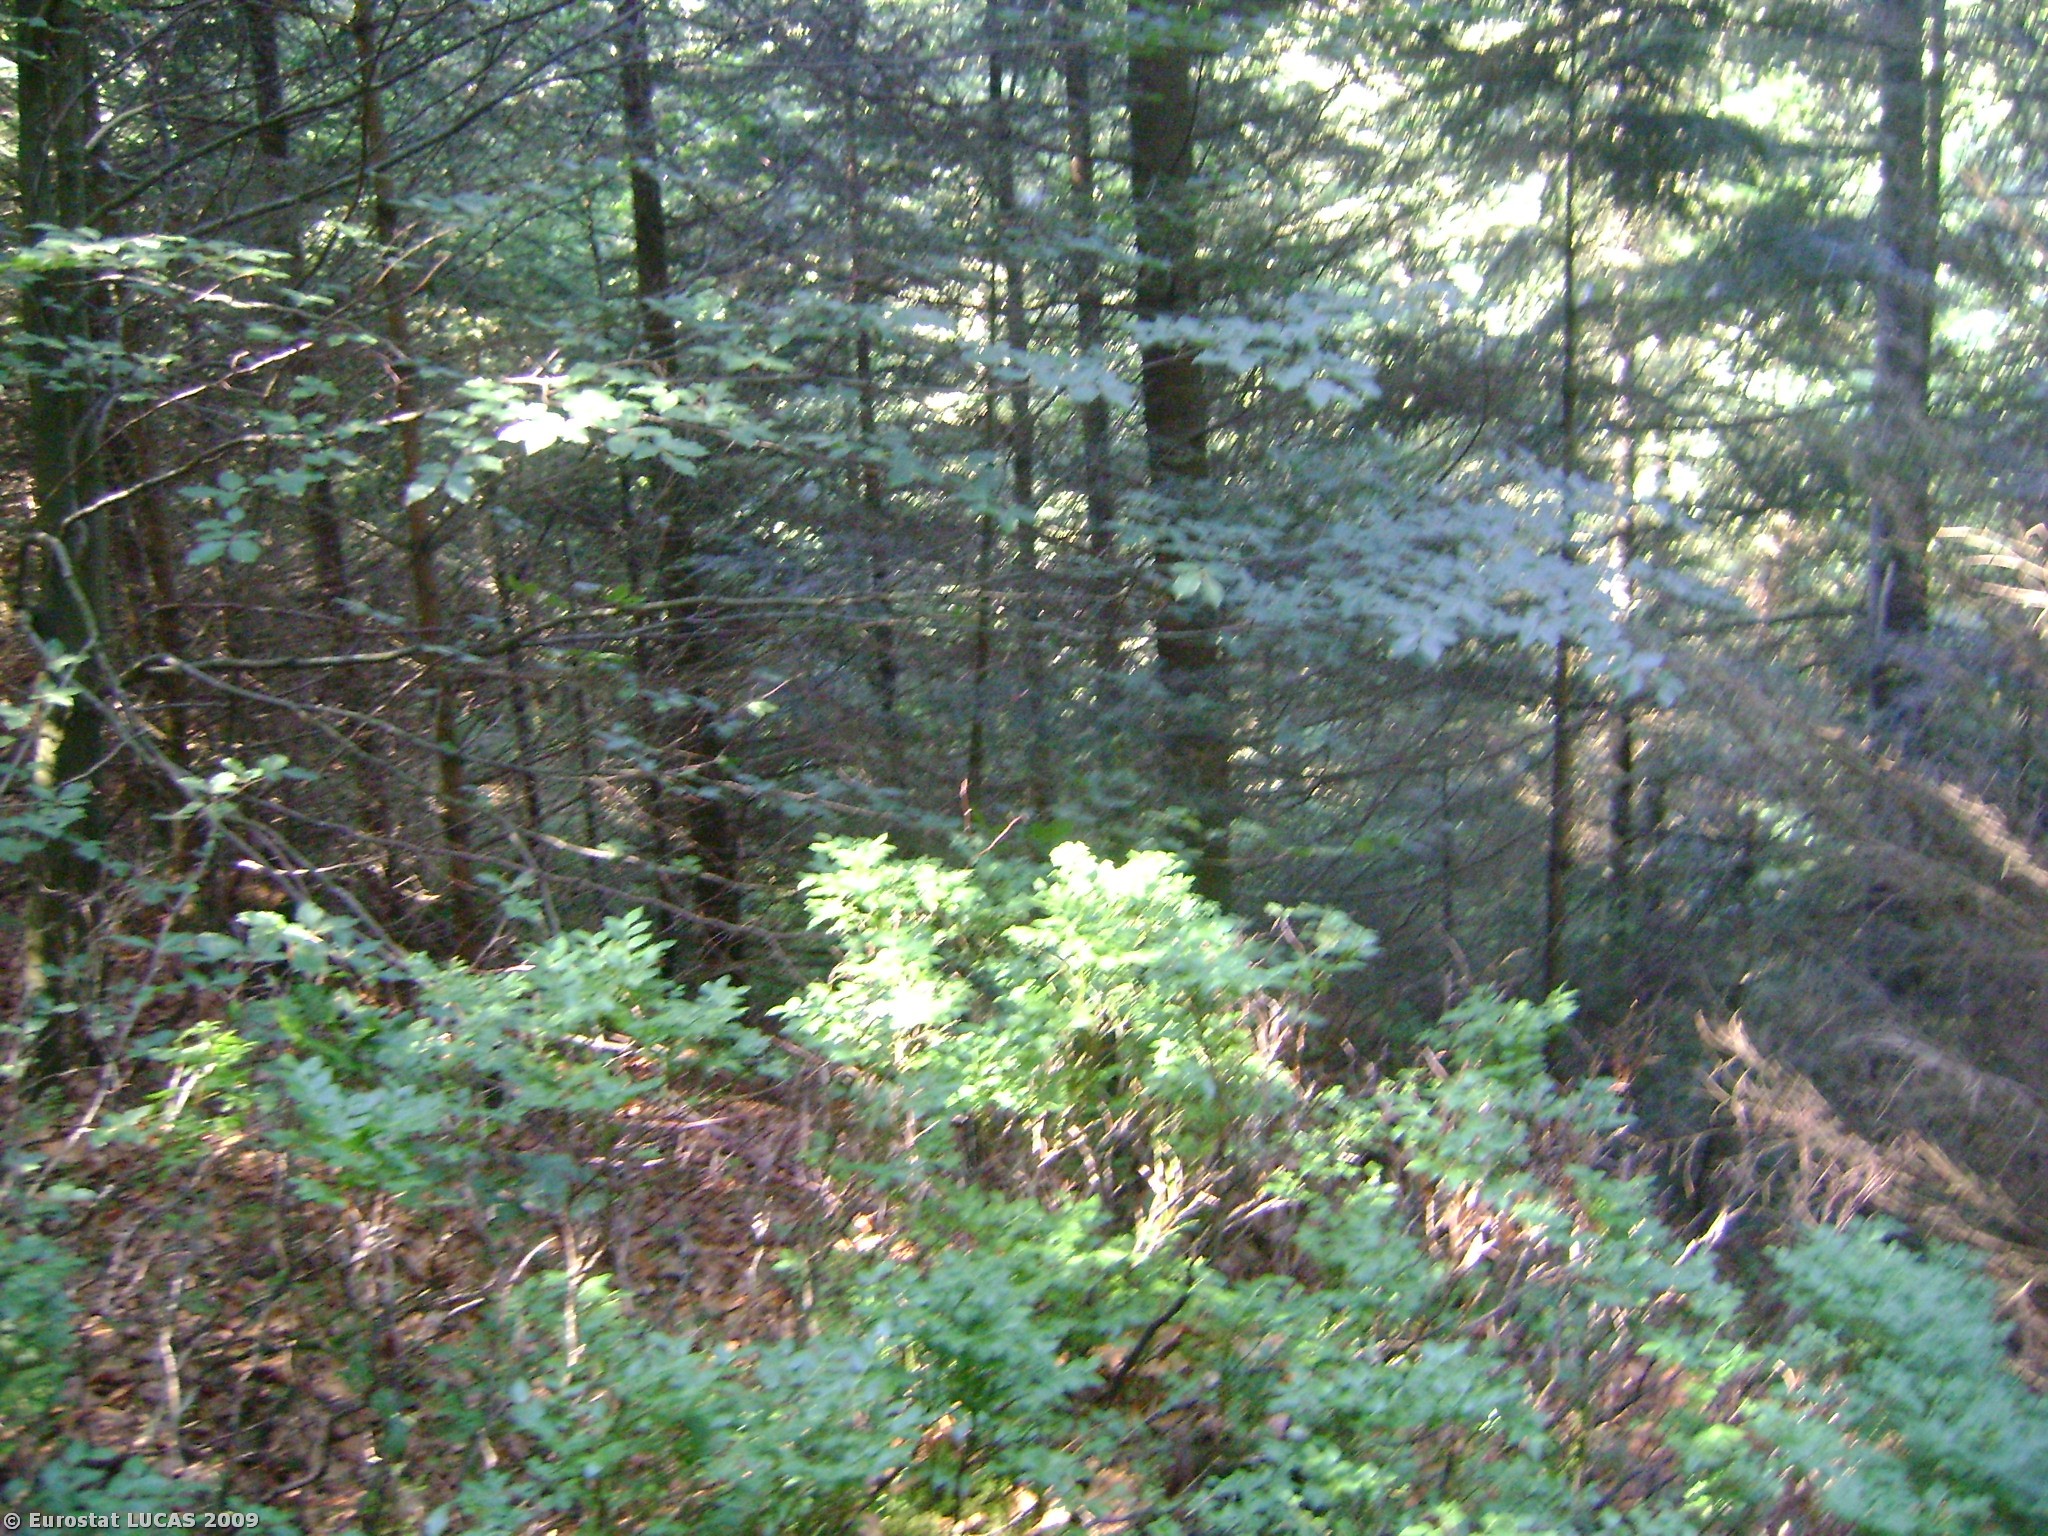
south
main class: Woodland
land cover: Coniferous woodland
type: hemiboreal forest and nemoral coniferous forest and mixed broadleaved-coniferous forest
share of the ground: > 75 %
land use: Forestry
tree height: > 5 m
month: June
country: AT
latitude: 48.0314
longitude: 13.2577
